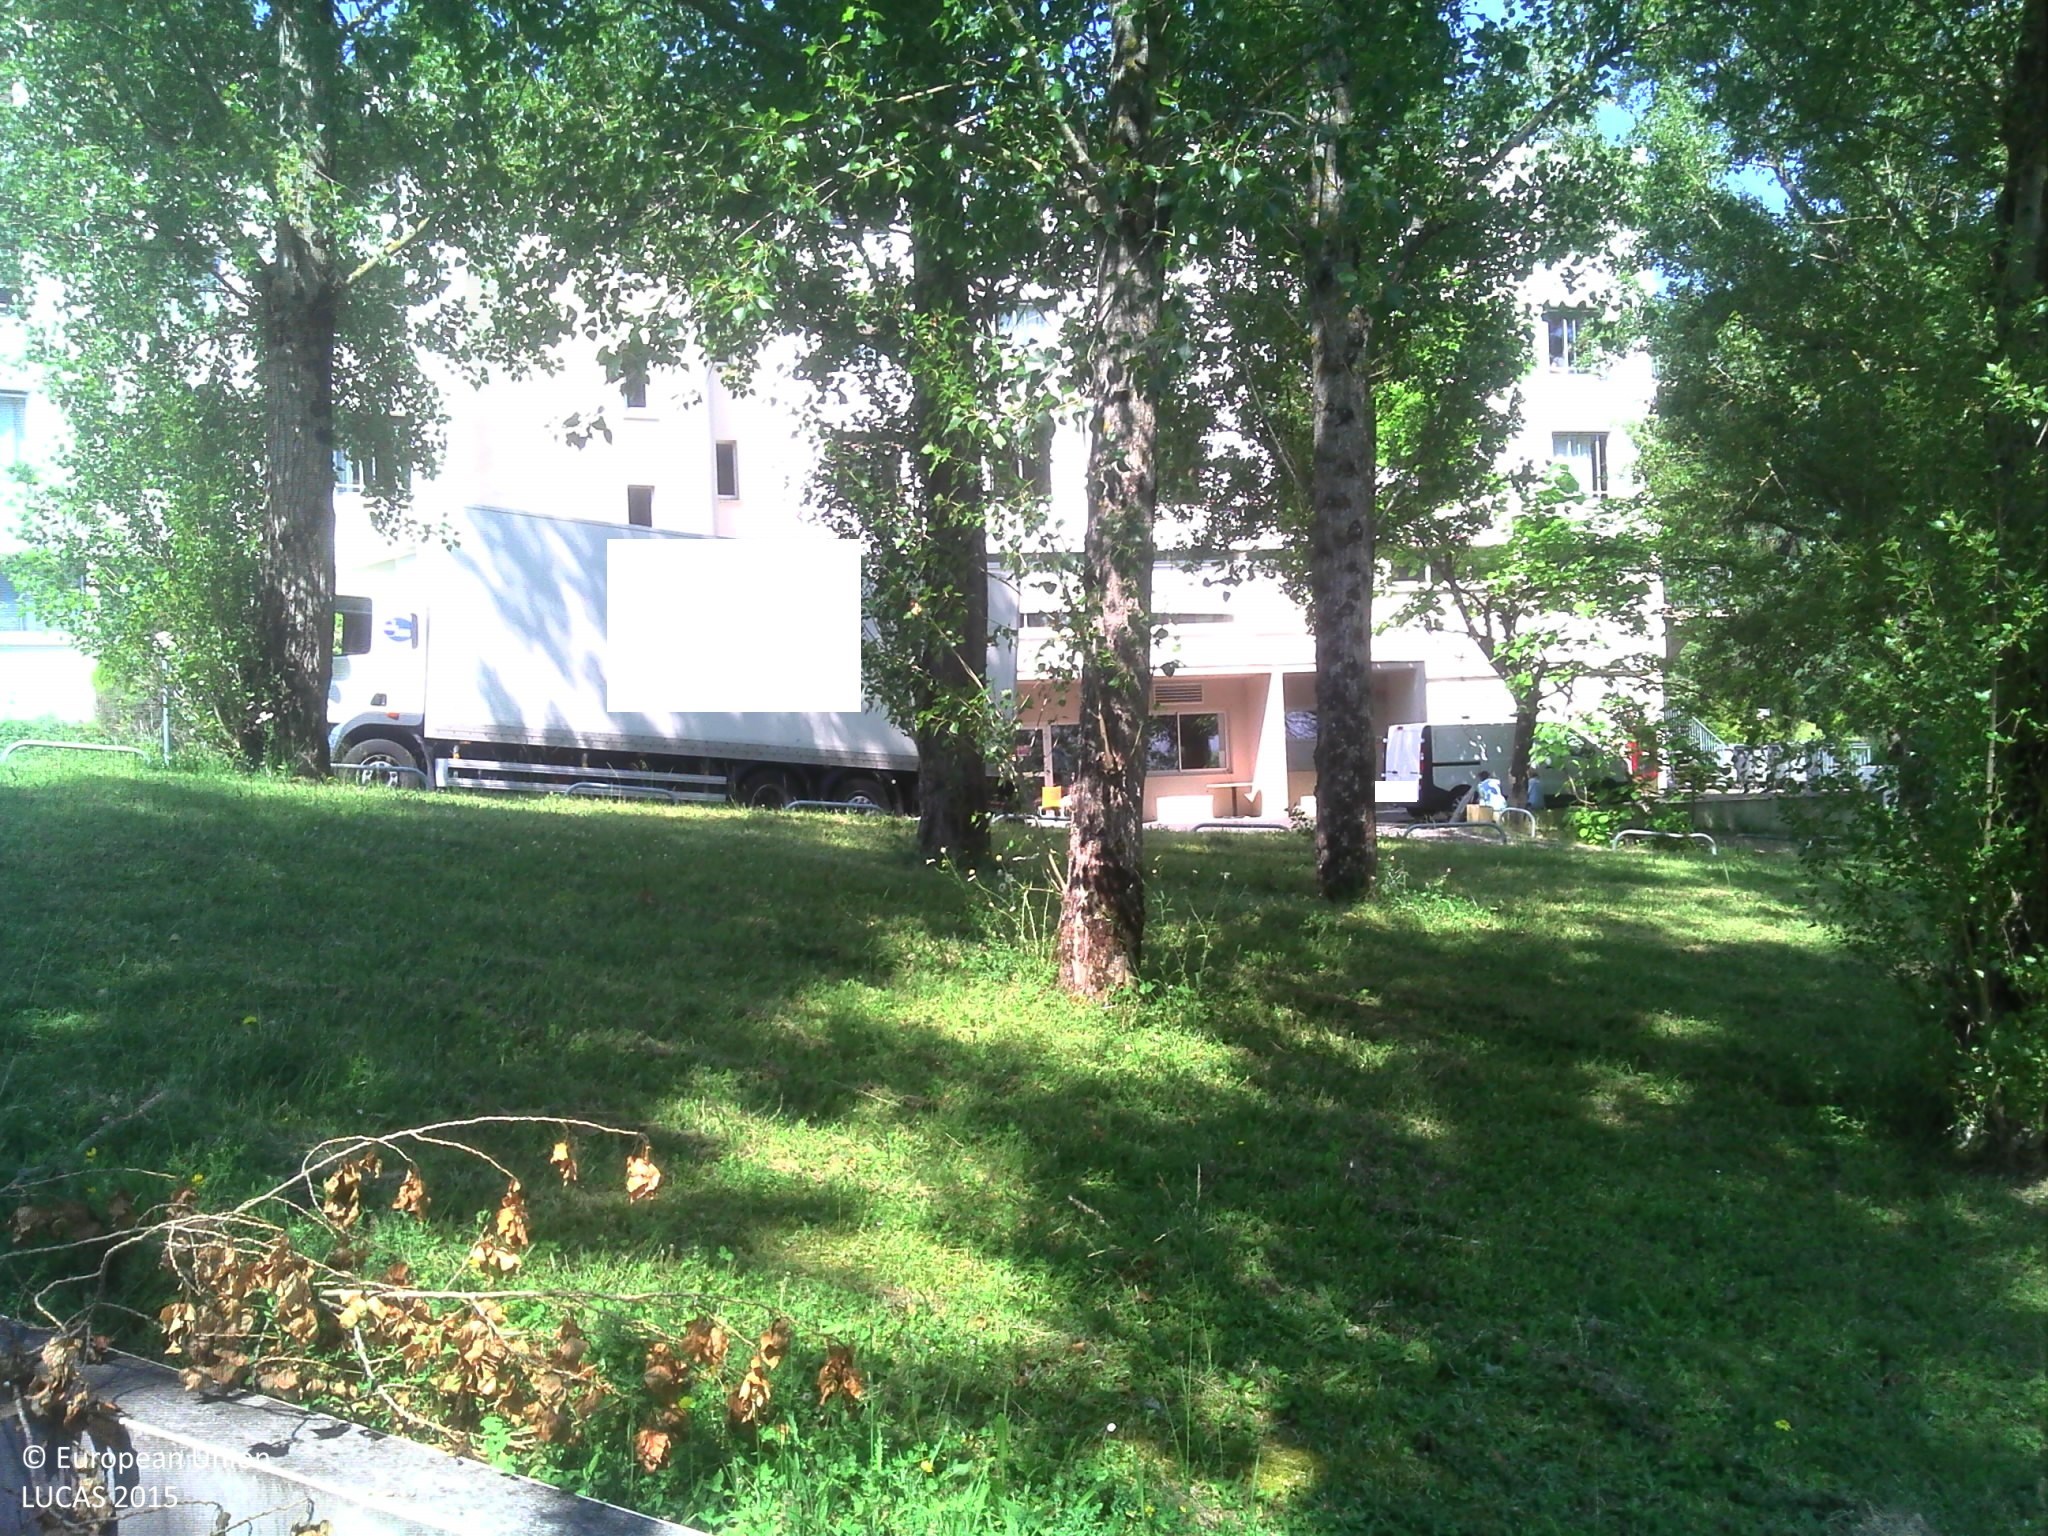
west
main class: Woodland
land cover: Broadleaved woodland
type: mesophytic deciduous forest
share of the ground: 50 - 75 %
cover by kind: broadleaved forest trees 65 %, herbaceous plants 35 %
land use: Residential
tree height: > 5 m
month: June
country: FR
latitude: 43.4679
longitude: 2.0825
